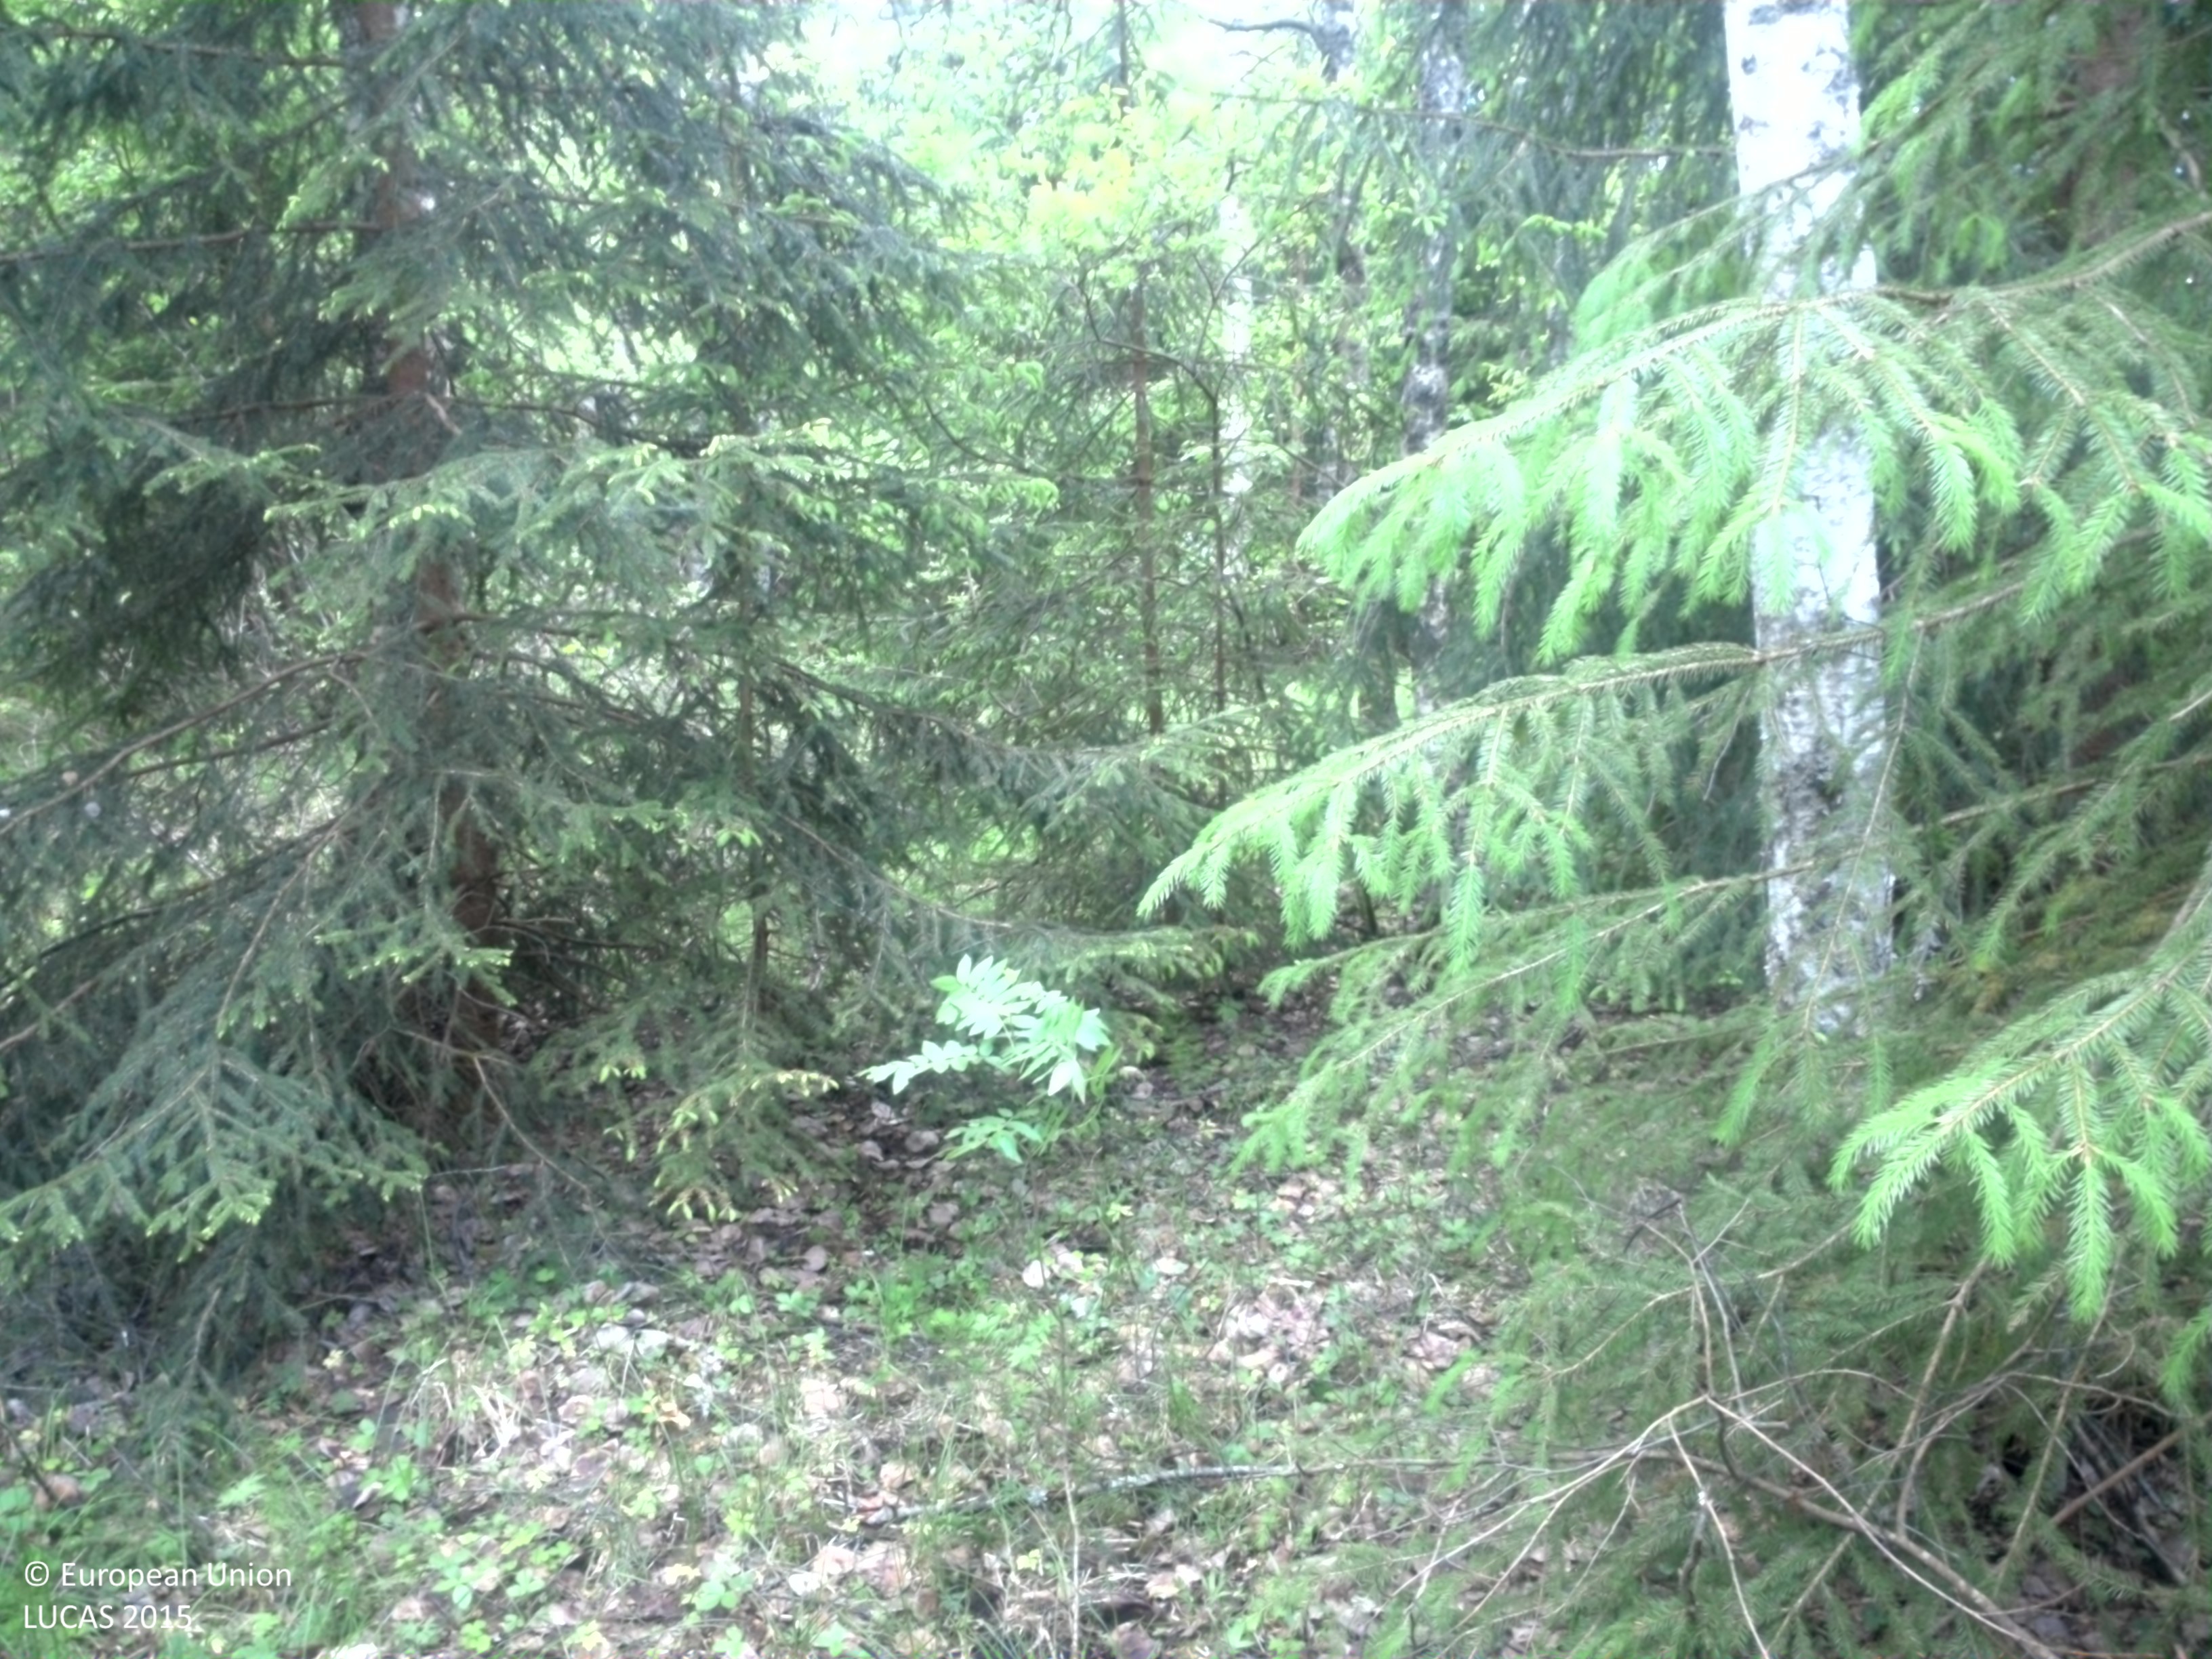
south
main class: Woodland
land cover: Spruce dominated mixed woodland
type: boreal forest
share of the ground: 50 - 75 %
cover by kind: broadleaved forest trees 50 %, coniferous forest trees 20 %, shrubs 15 %, herbaceous plants 15 %
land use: Forestry
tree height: > 5 m
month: June
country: SE
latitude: 59.5239
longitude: 14.1805
